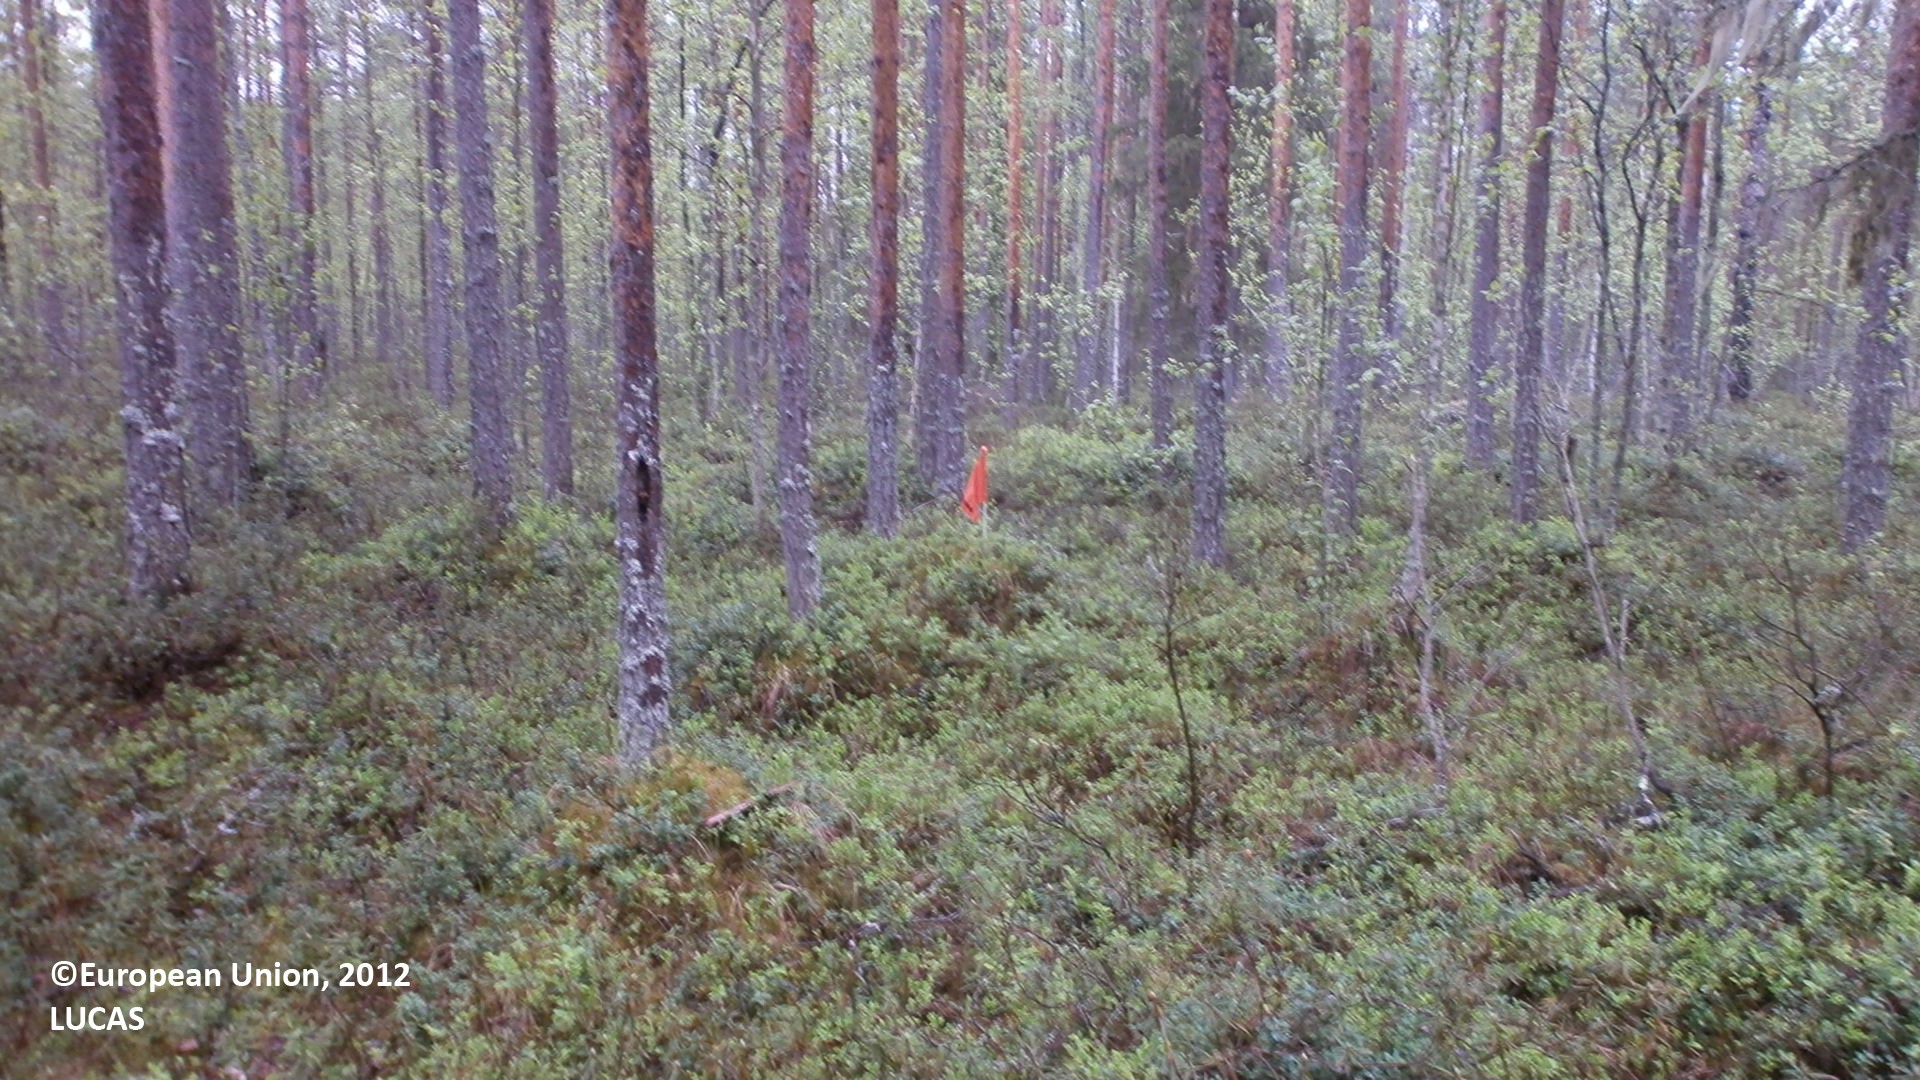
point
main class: Woodland
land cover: Pine dominated coniferous woodland
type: mire and swamp forests
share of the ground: 50 - 75 %
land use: Forestry
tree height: > 5 m
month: June
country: FI
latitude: 64.1227
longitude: 26.1065
